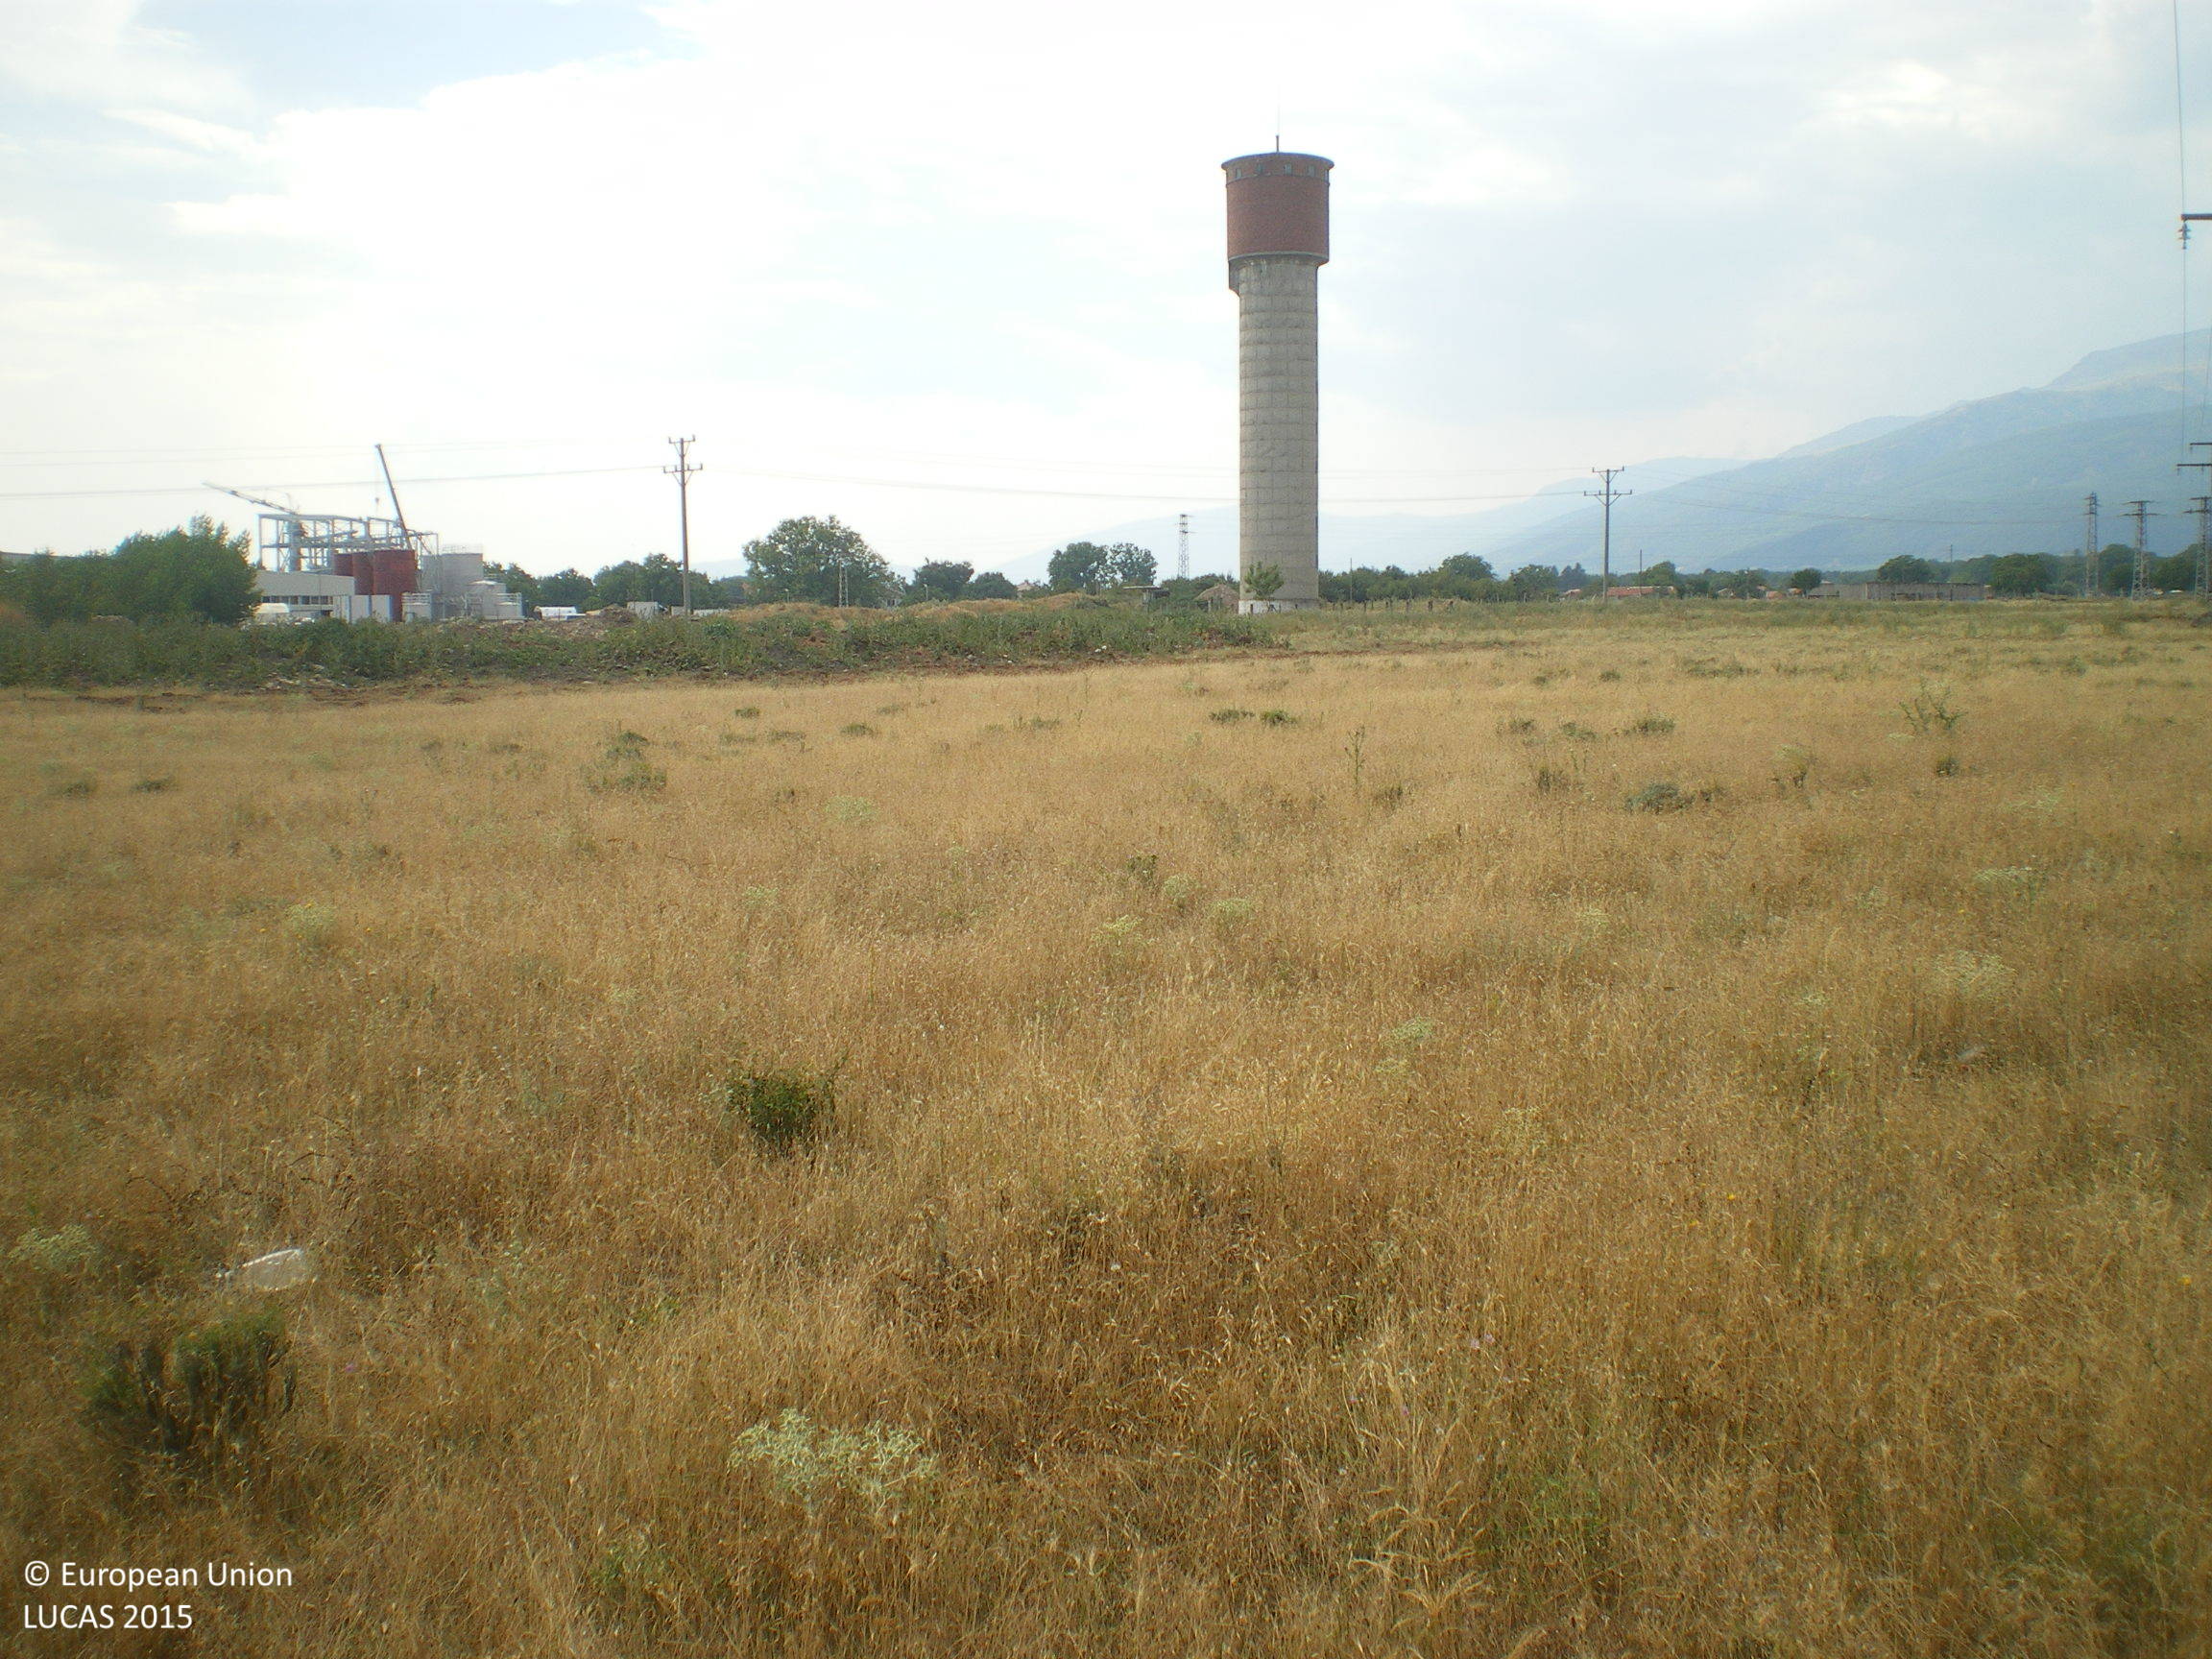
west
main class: Grassland
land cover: Grassland without tree/shrub cover
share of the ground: > 75 %
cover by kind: herbaceous plants 100 %
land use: Semi-natural and natural areas not in use
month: July
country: BG
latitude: 42.6504
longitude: 25.2283
